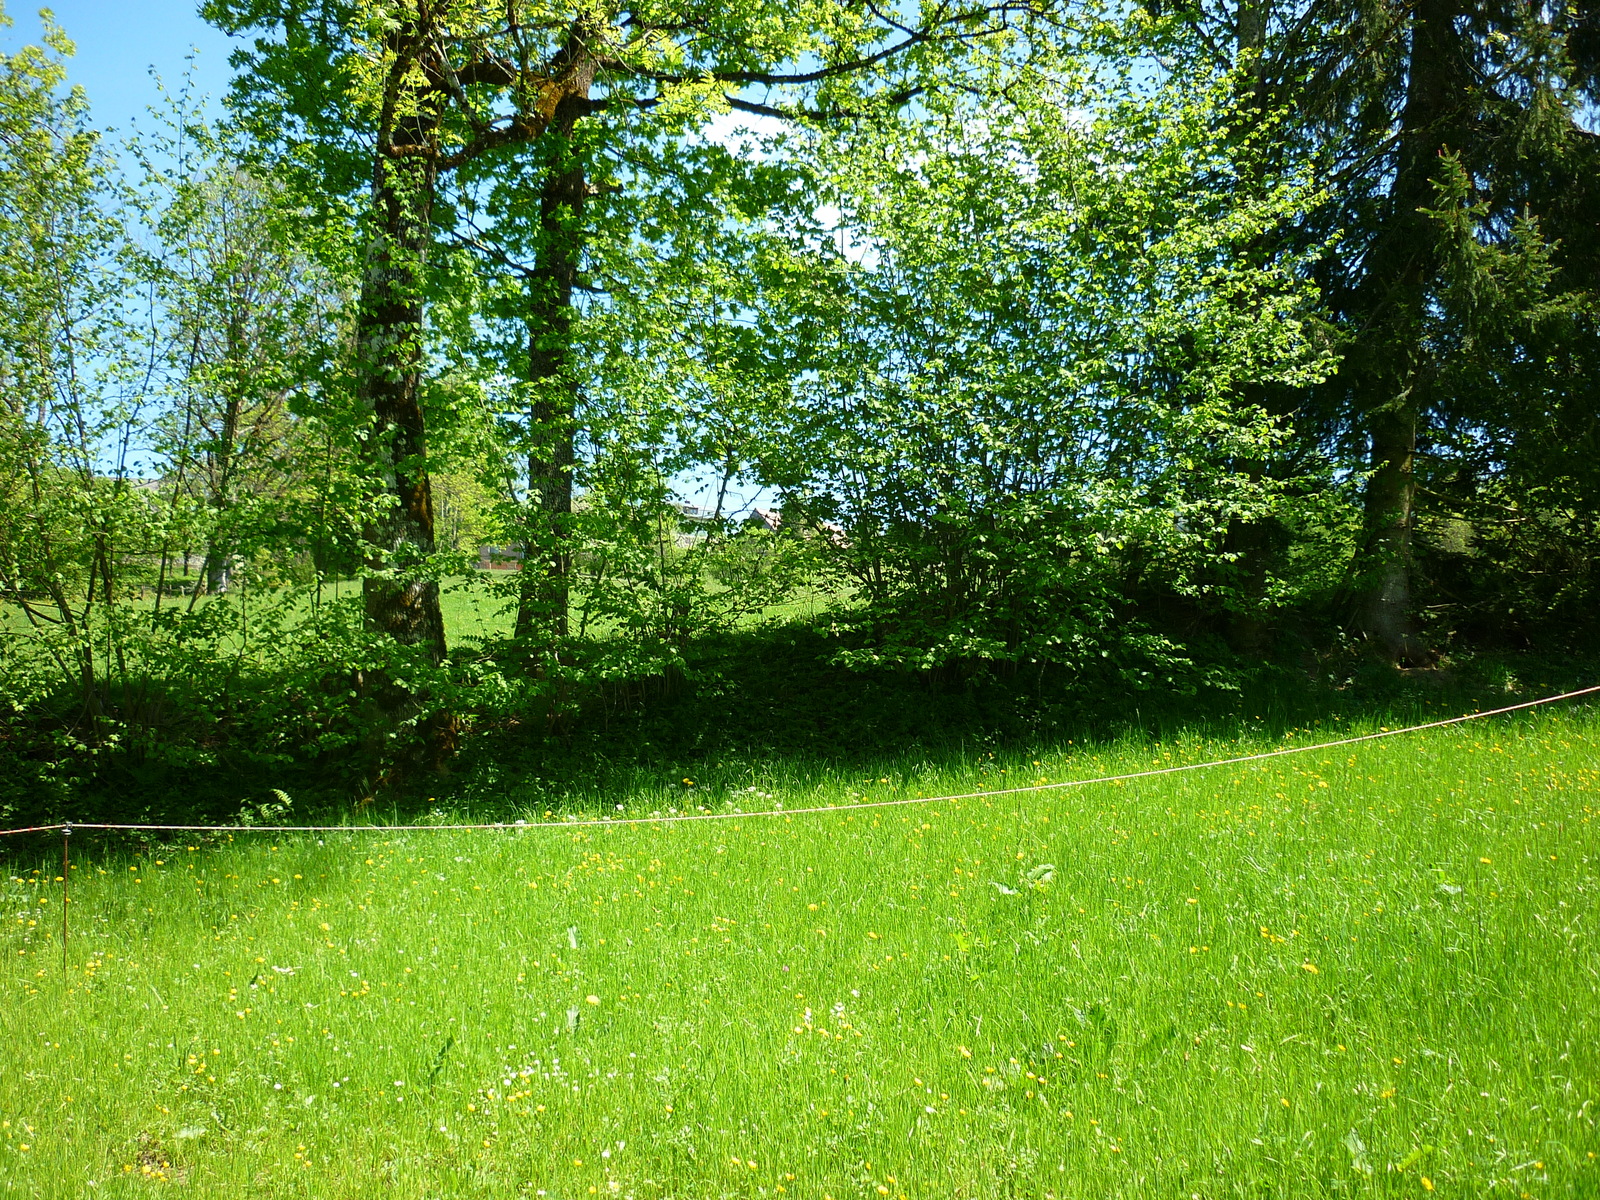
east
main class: Grassland
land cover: Grassland without tree/shrub cover
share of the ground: > 75 %
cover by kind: herbaceous plants 100 %
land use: Agriculture (excluding fallow land and kitchen gardens)
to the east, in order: Grassland without tree/shrub cover; Fences; Broadleaved woodland; Grassland without tree/shrub cover; Fences; Other fruit trees and berries; Fences; Grassland without tree/shrub cover
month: May
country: AT
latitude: 47.6512
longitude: 14.7793
